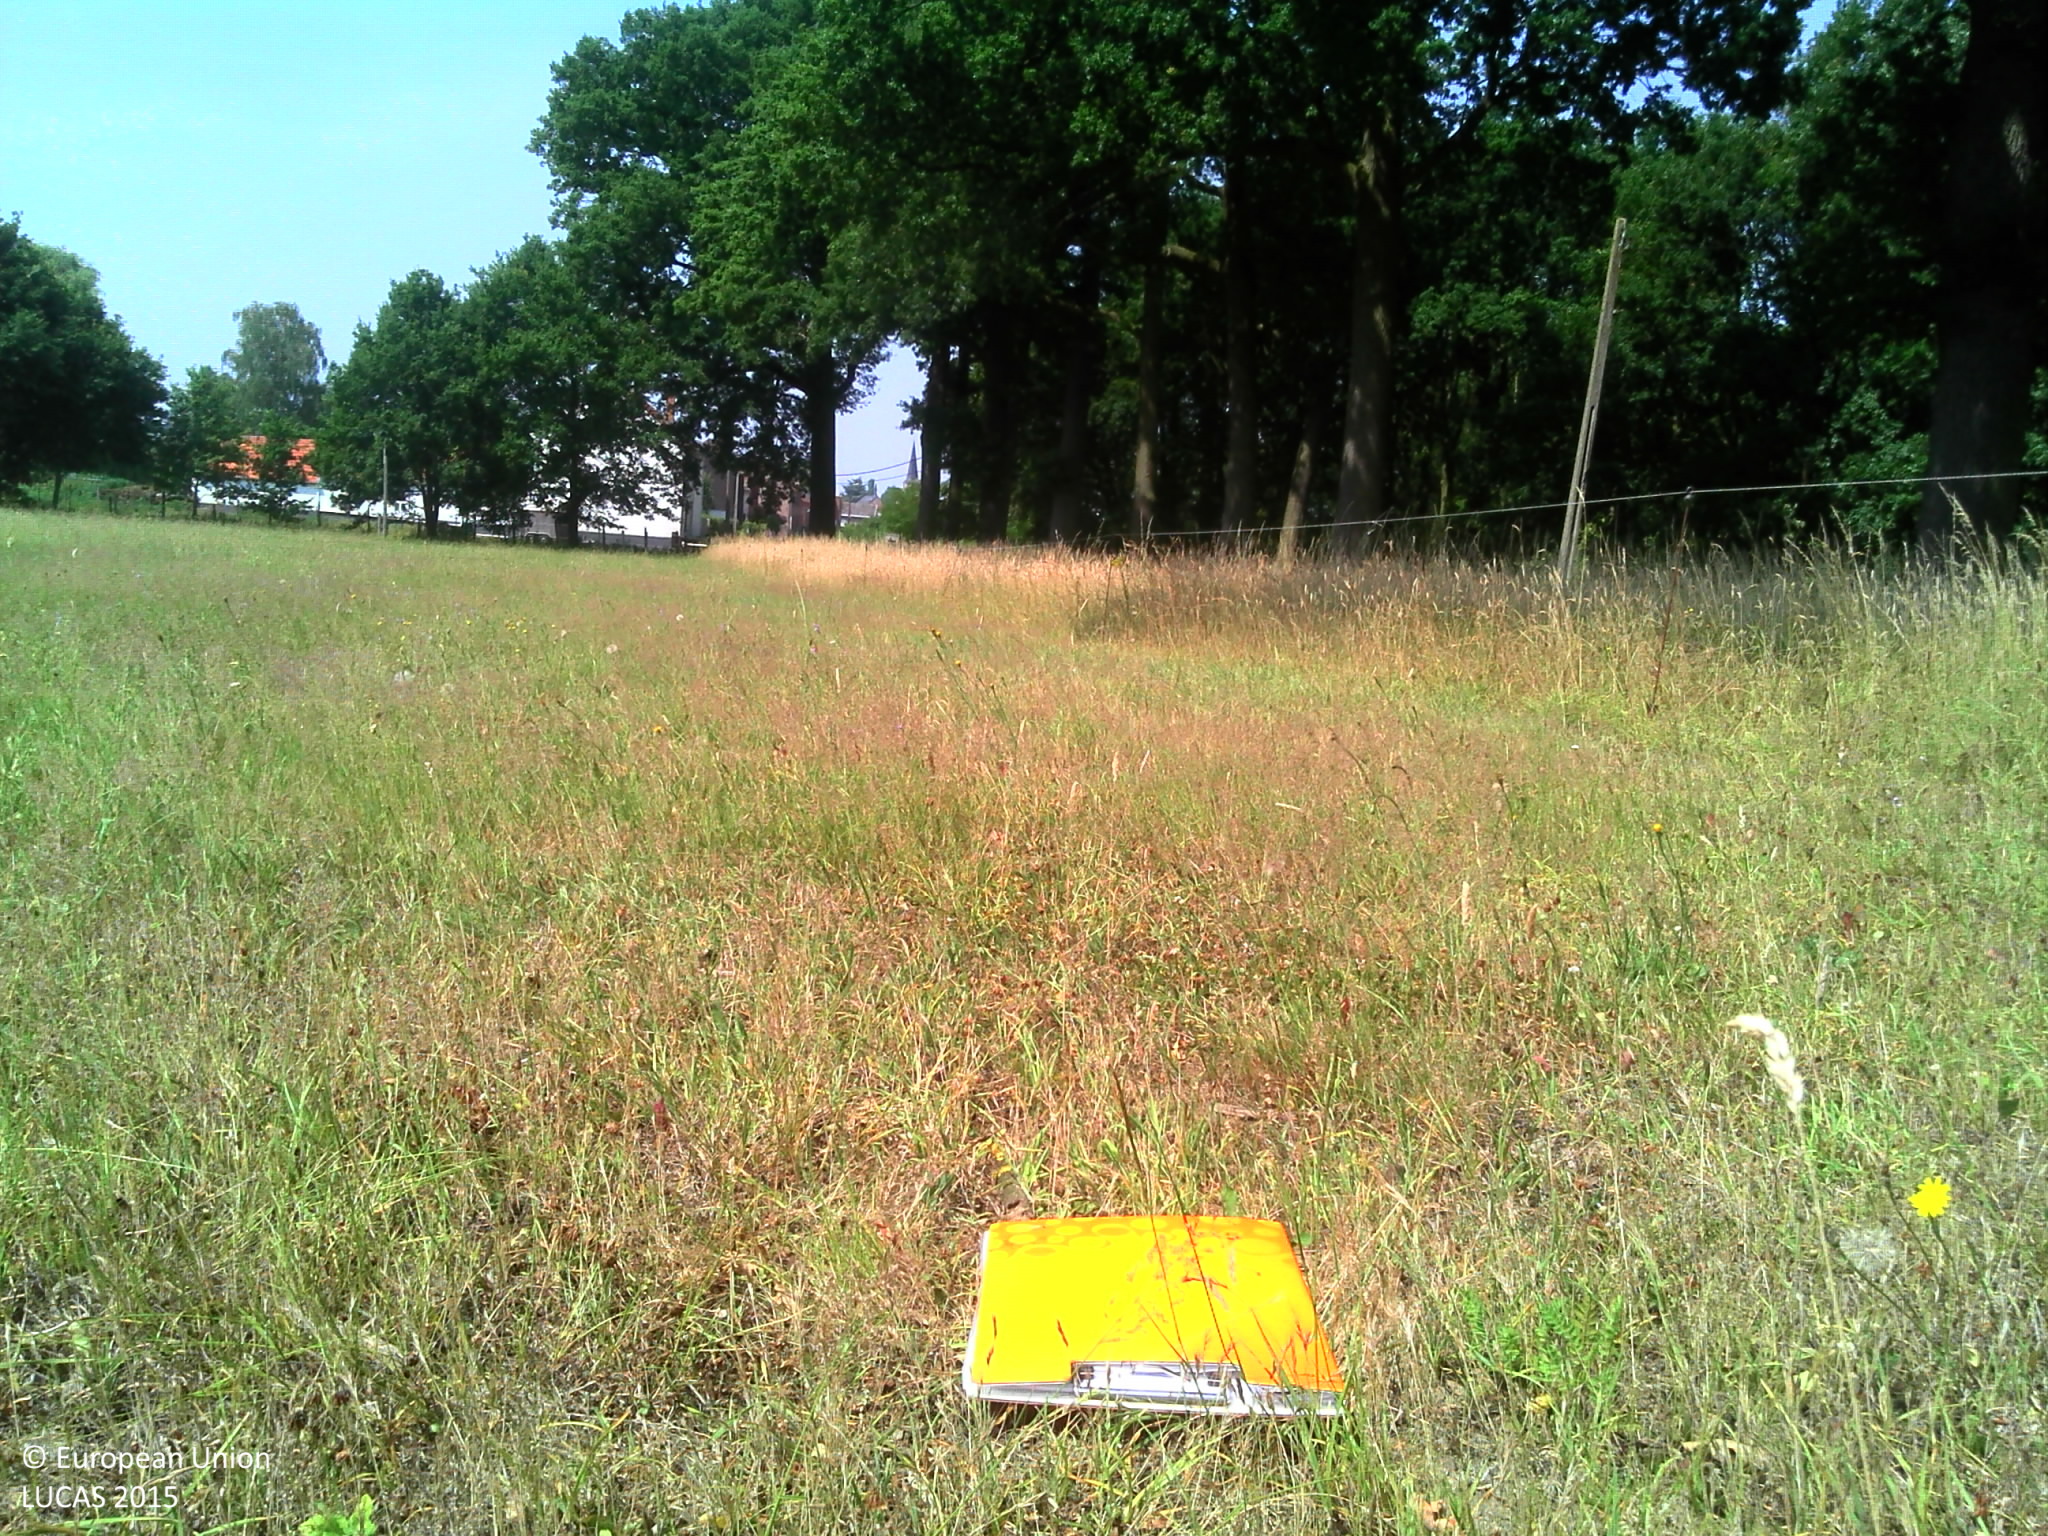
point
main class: Grassland
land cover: Grassland without tree/shrub cover
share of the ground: > 75 %
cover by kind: herbaceous plants 95 %, shrubs 5 %
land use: Agriculture (excluding fallow land and kitchen gardens)
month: July
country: BE
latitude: 50.9319
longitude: 4.8316
